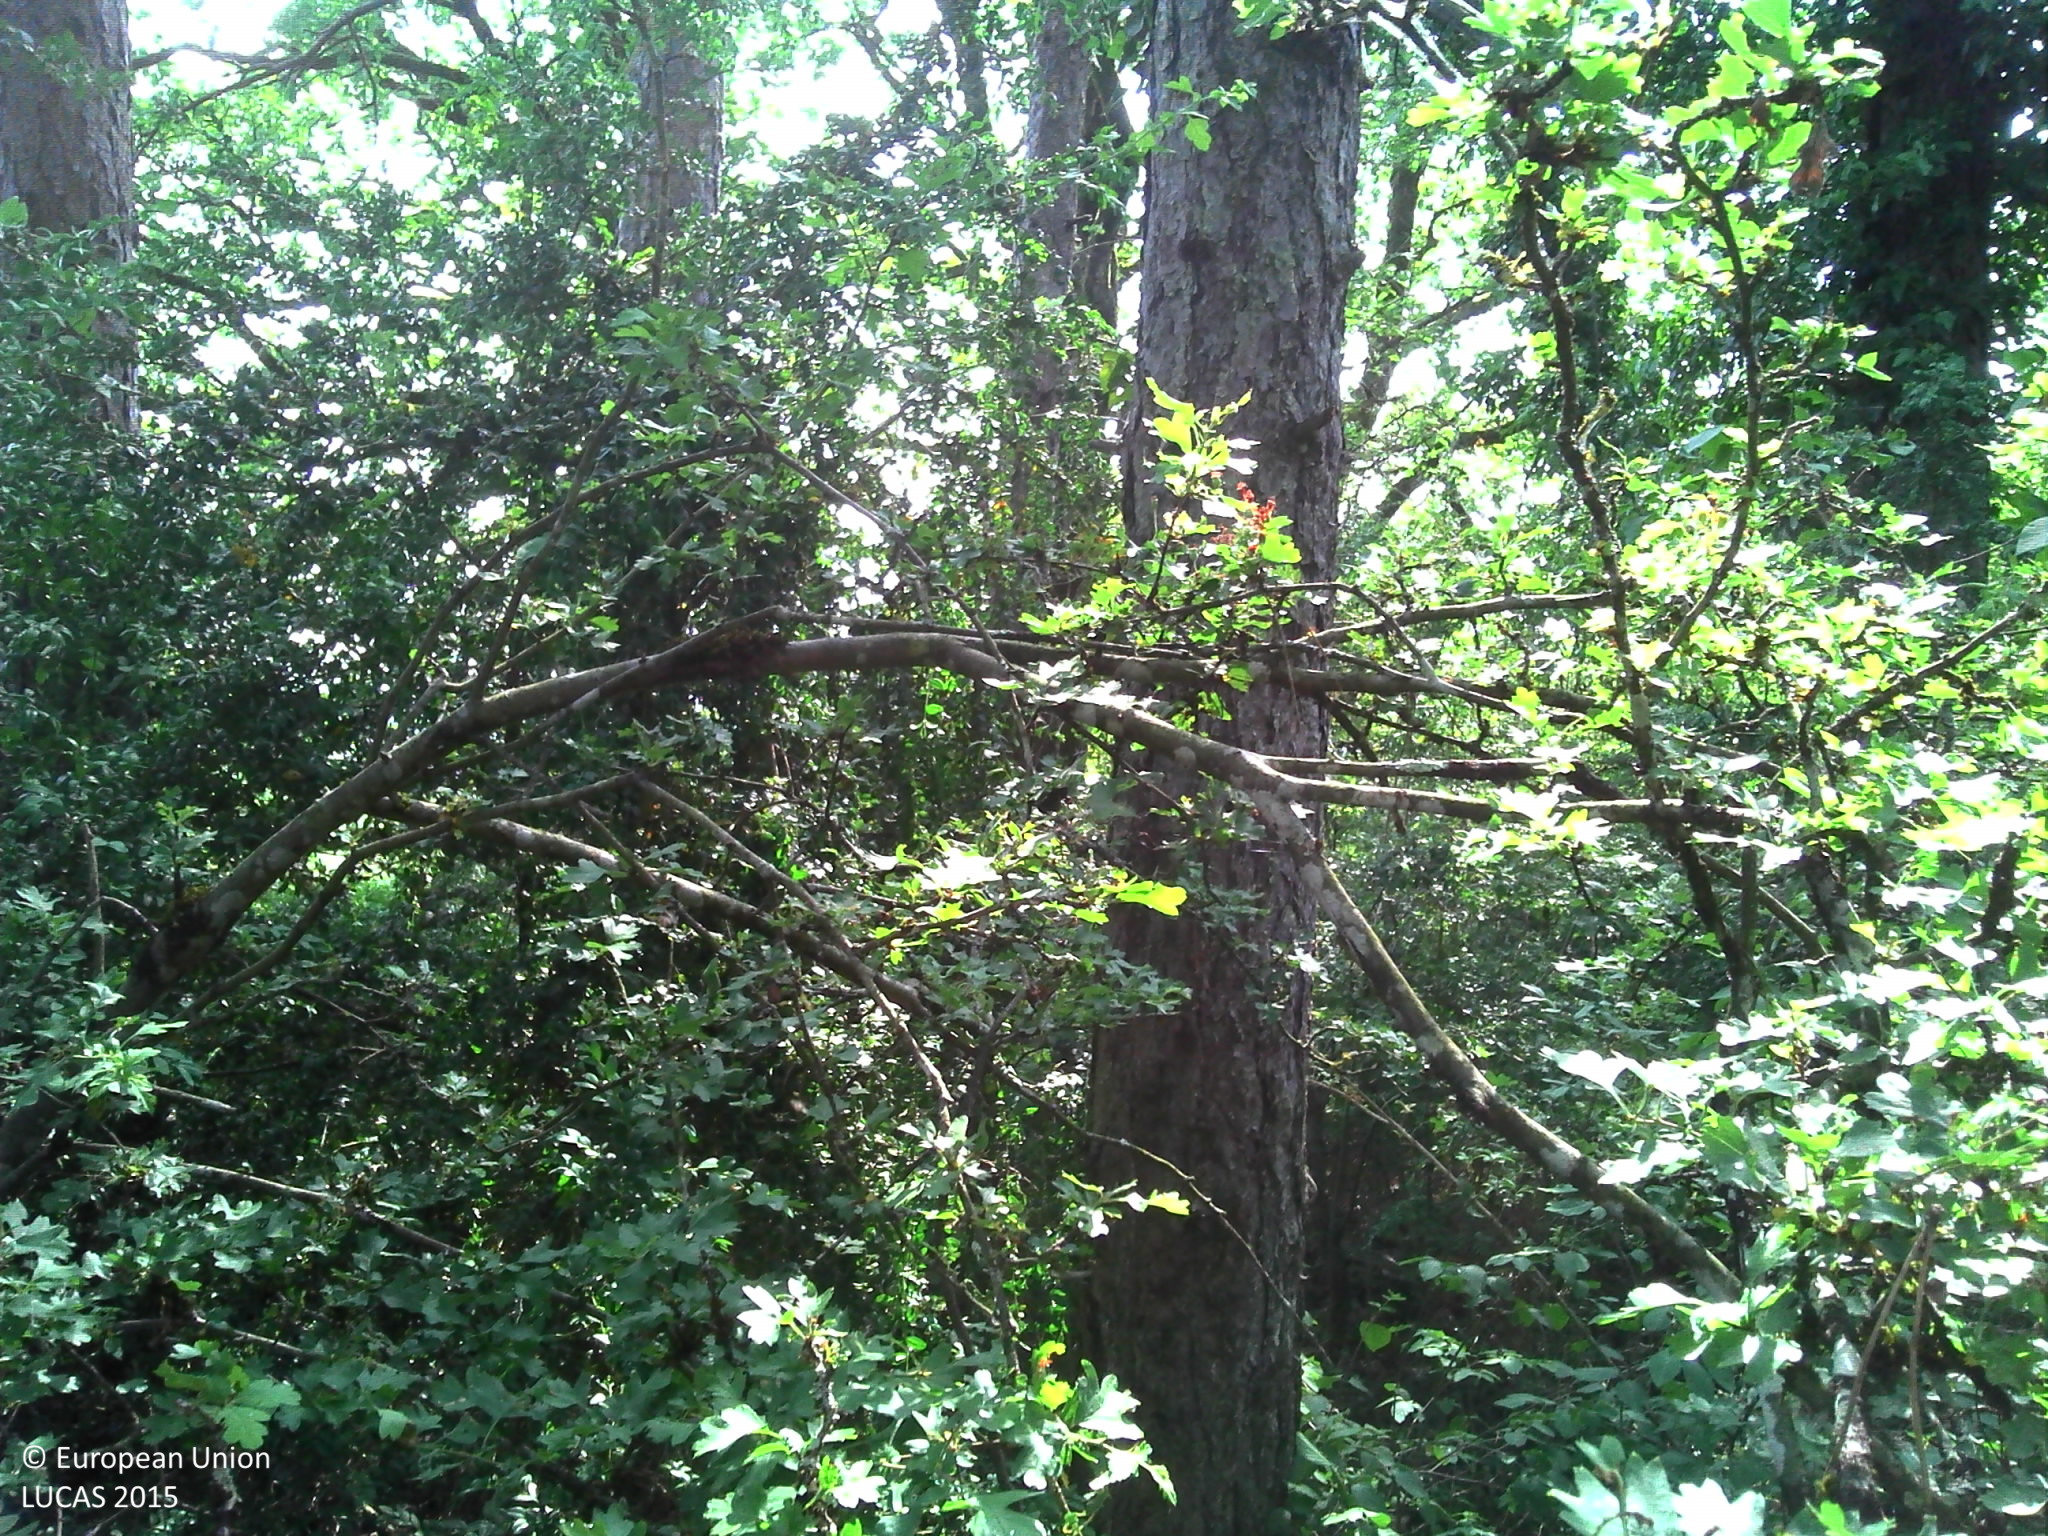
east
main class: Woodland
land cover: Pine dominated mixed woodland
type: hemiboreal forest and nemoral coniferous forest and mixed broadleaved-coniferous forest
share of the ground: > 75 %
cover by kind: coniferous forest trees 50 %, broadleaved forest trees 25 %, shrubs 10 %, lichens and mosses 10 %, herbaceous plants 5 %
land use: Forestry
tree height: > 5 m
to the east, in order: Pine dominated mixed woodland; Grass margins; Fences; Pine dominated mixed woodland; Paved roads, cycling and walking lanes; Electric lines; Managed hedges; Artificial constructions in urban areas; Broadleaved woodland; Tracks; Grassland without tree/shrub cover; Tracks; Vineyards
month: June
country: FR
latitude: 47.0561
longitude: 4.8269
